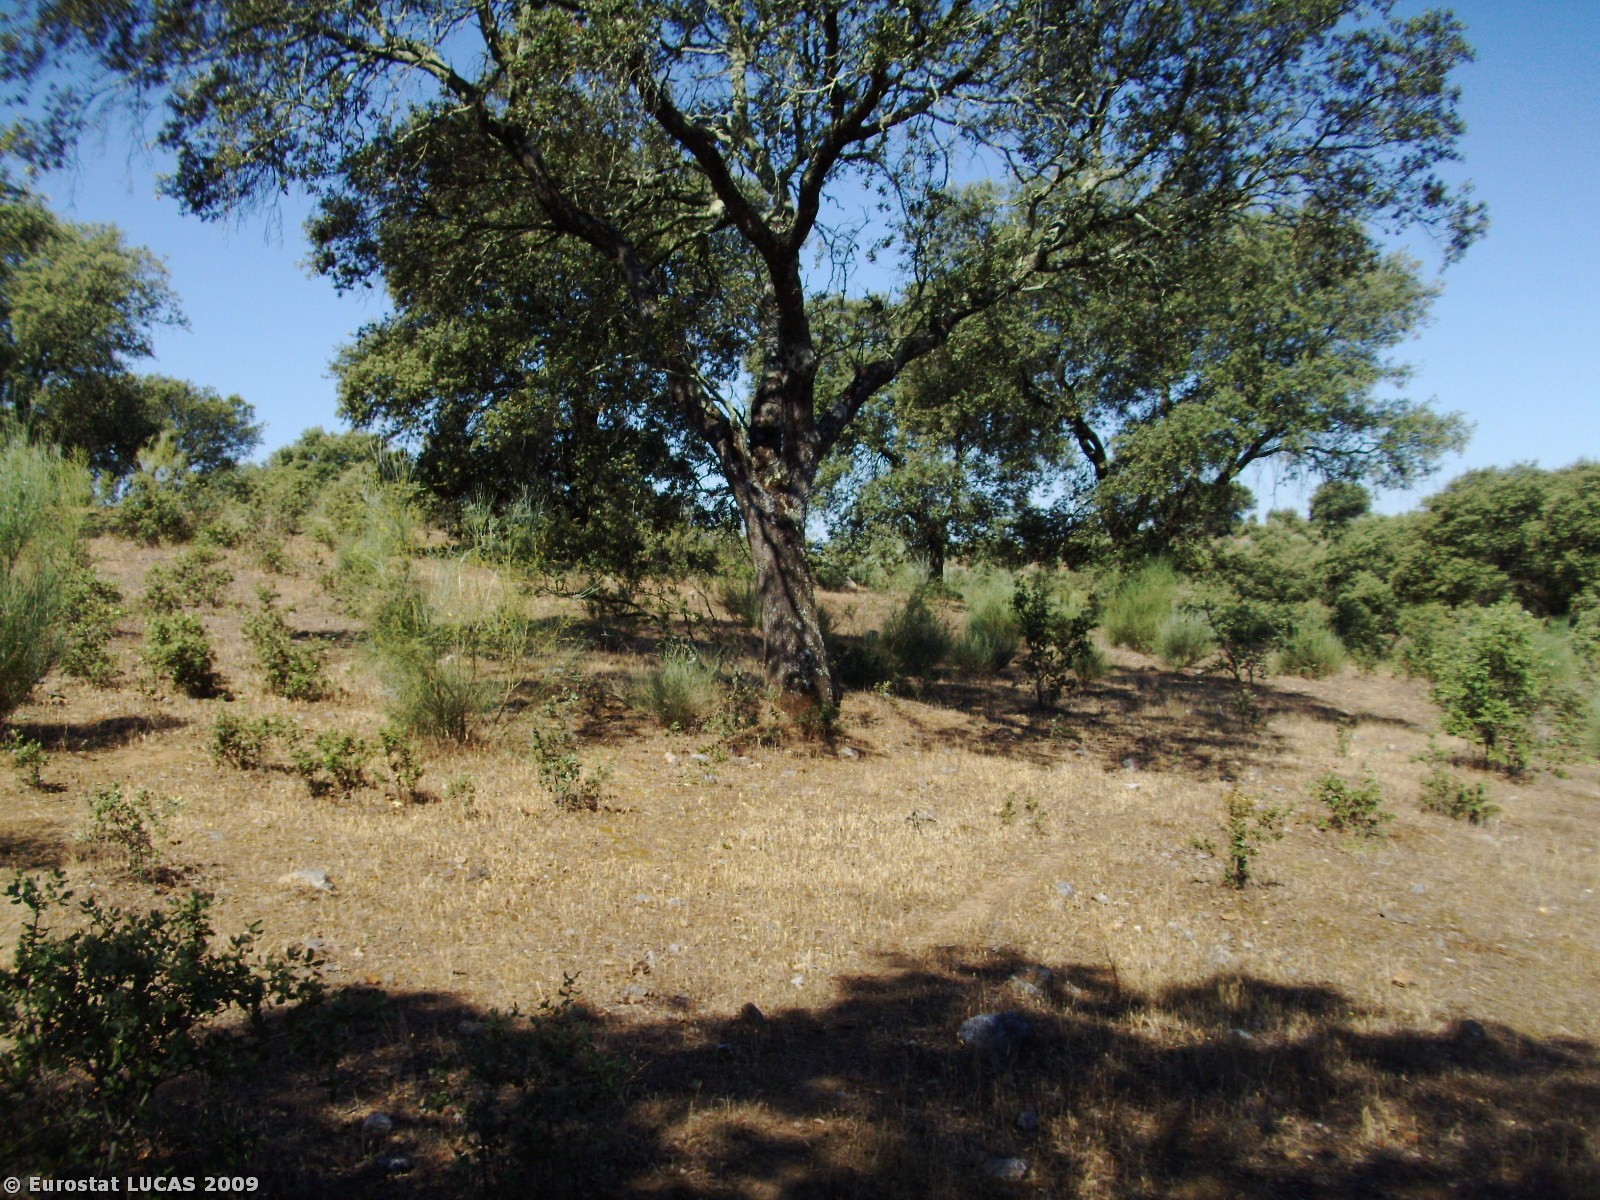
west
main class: Woodland
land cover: Broadleaved woodland
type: broadleaved evergreen forest
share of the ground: 10 - 25 %
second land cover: Spontaneously vegetated surfaces
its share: 50 - 75 %
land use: Forestry
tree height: > 5 m
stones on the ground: 25 - 50 %
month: June
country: PT
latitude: 39.9185
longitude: -7.1862
